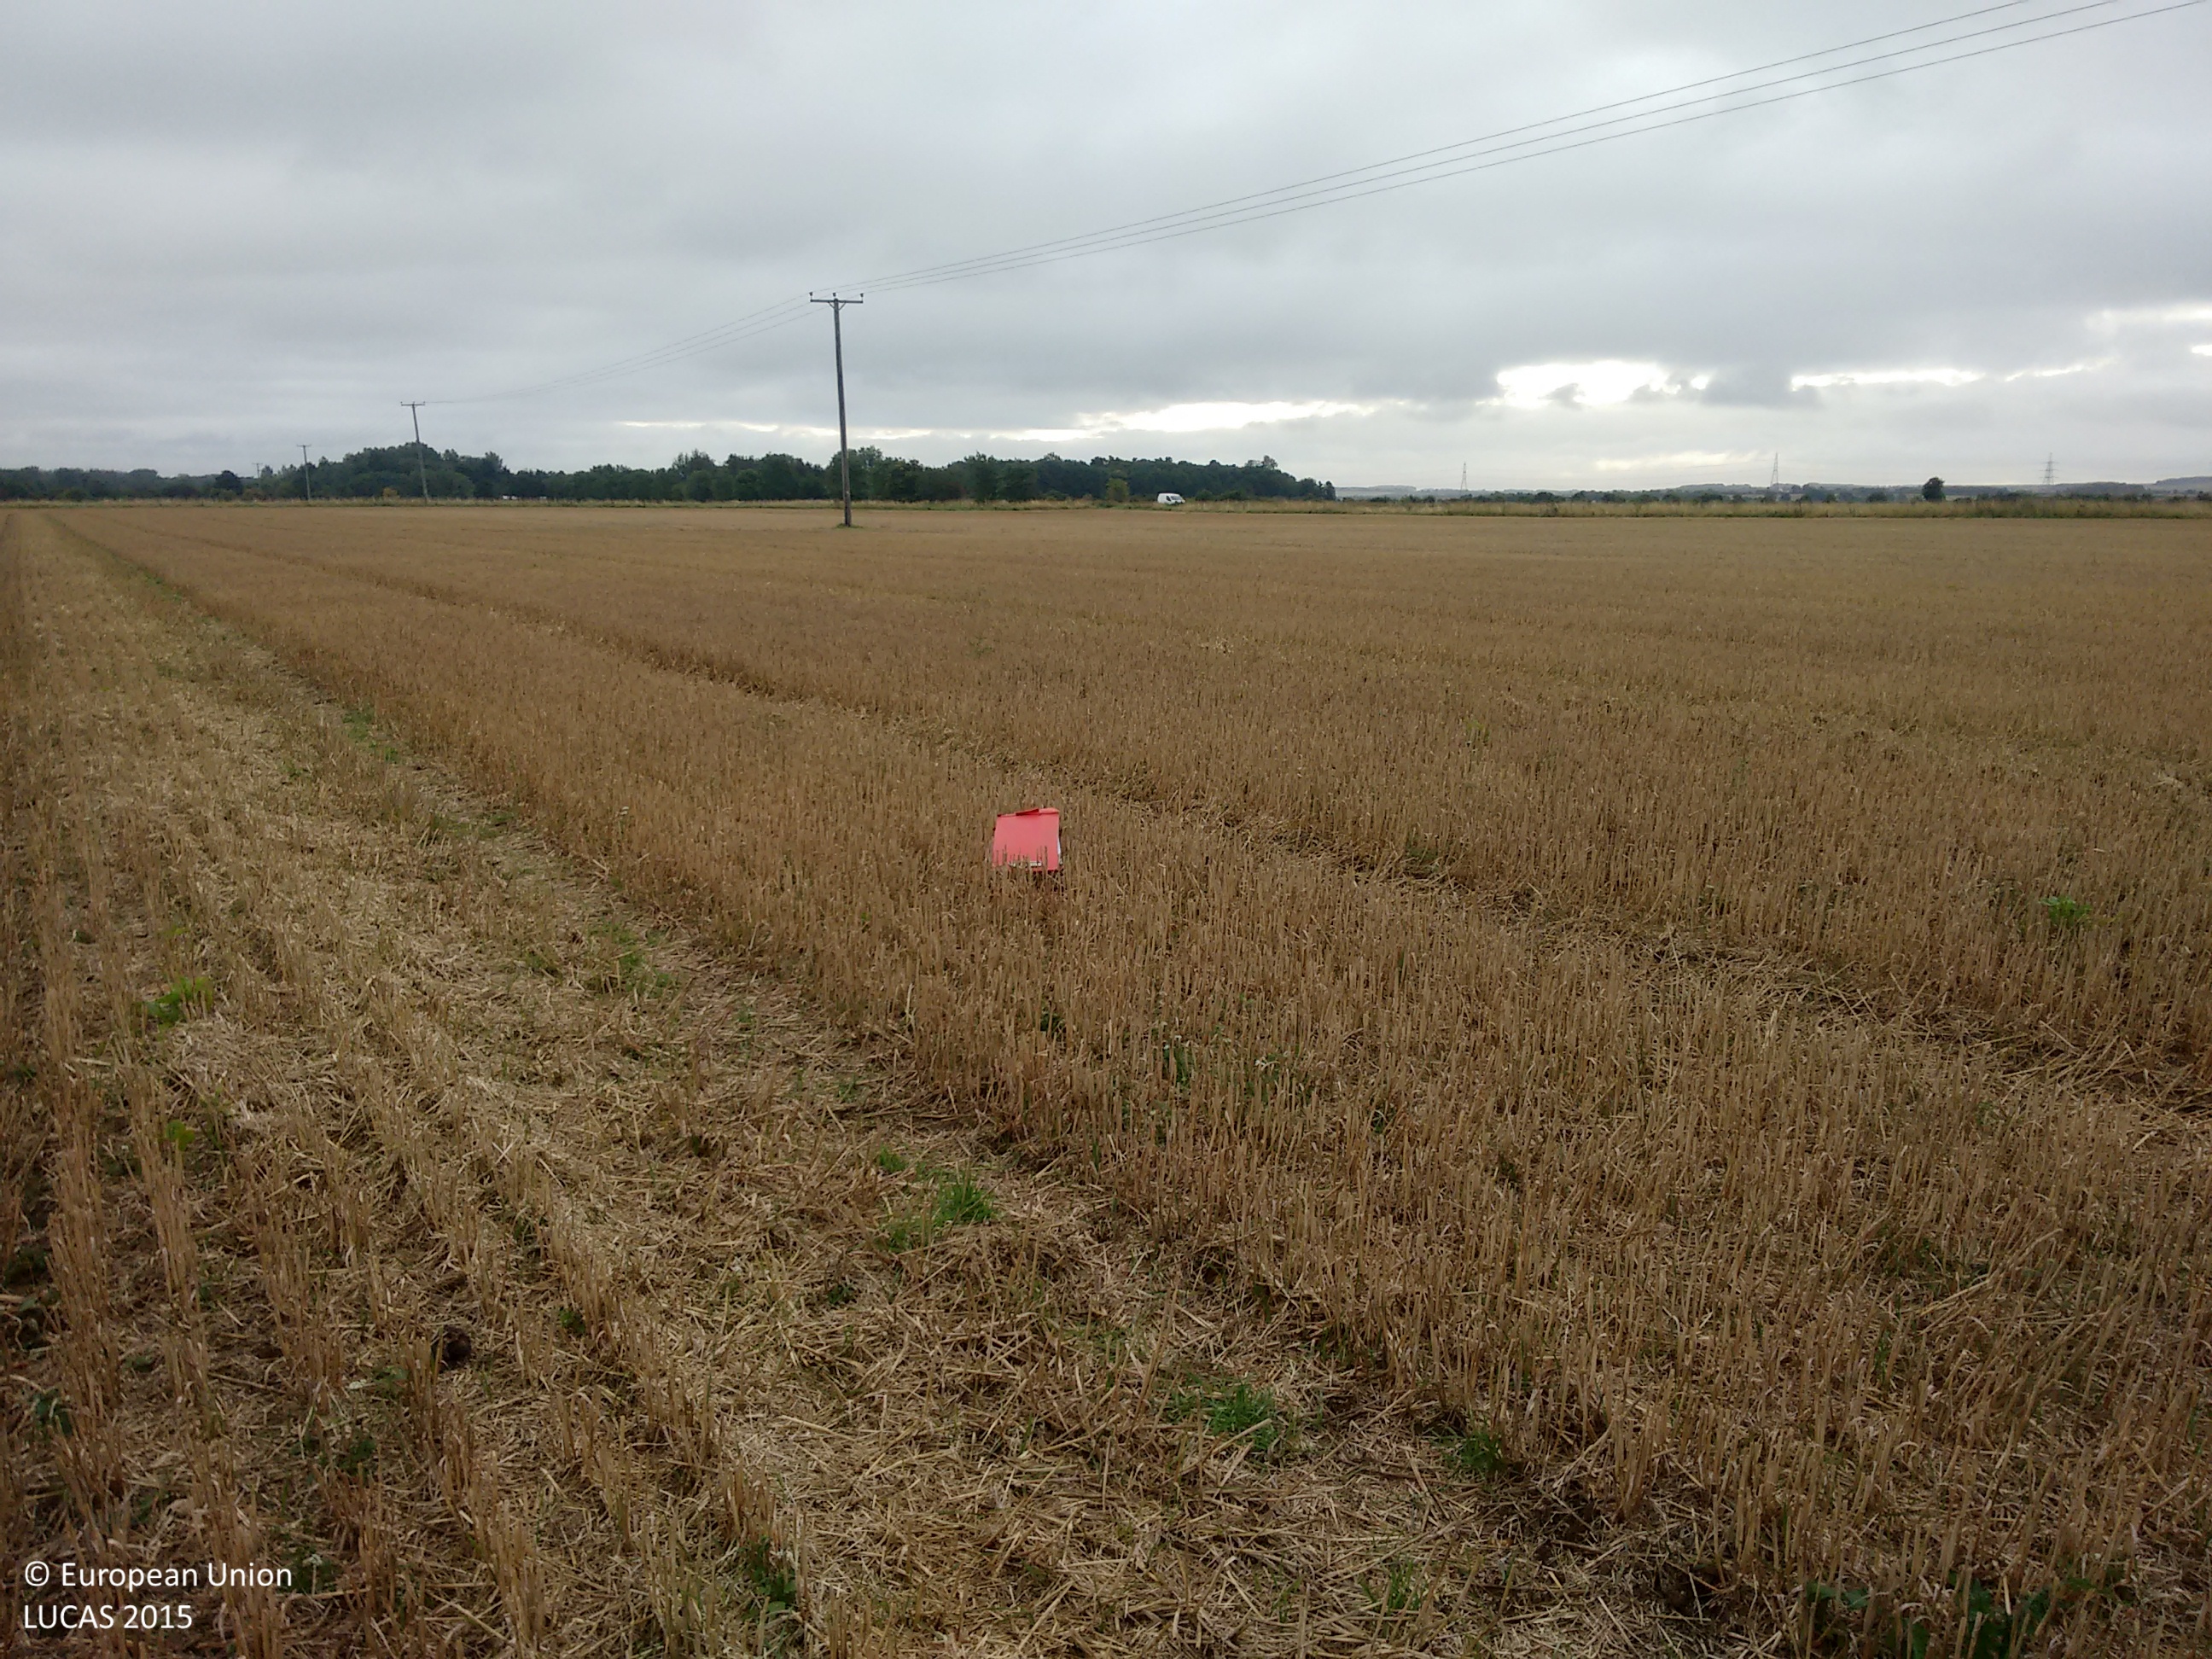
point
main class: Cropland
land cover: Common wheat
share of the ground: > 75 %
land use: Agriculture (excluding fallow land and kitchen gardens)
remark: Harvested field
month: September
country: GB
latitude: 52.1919
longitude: 0.2418
